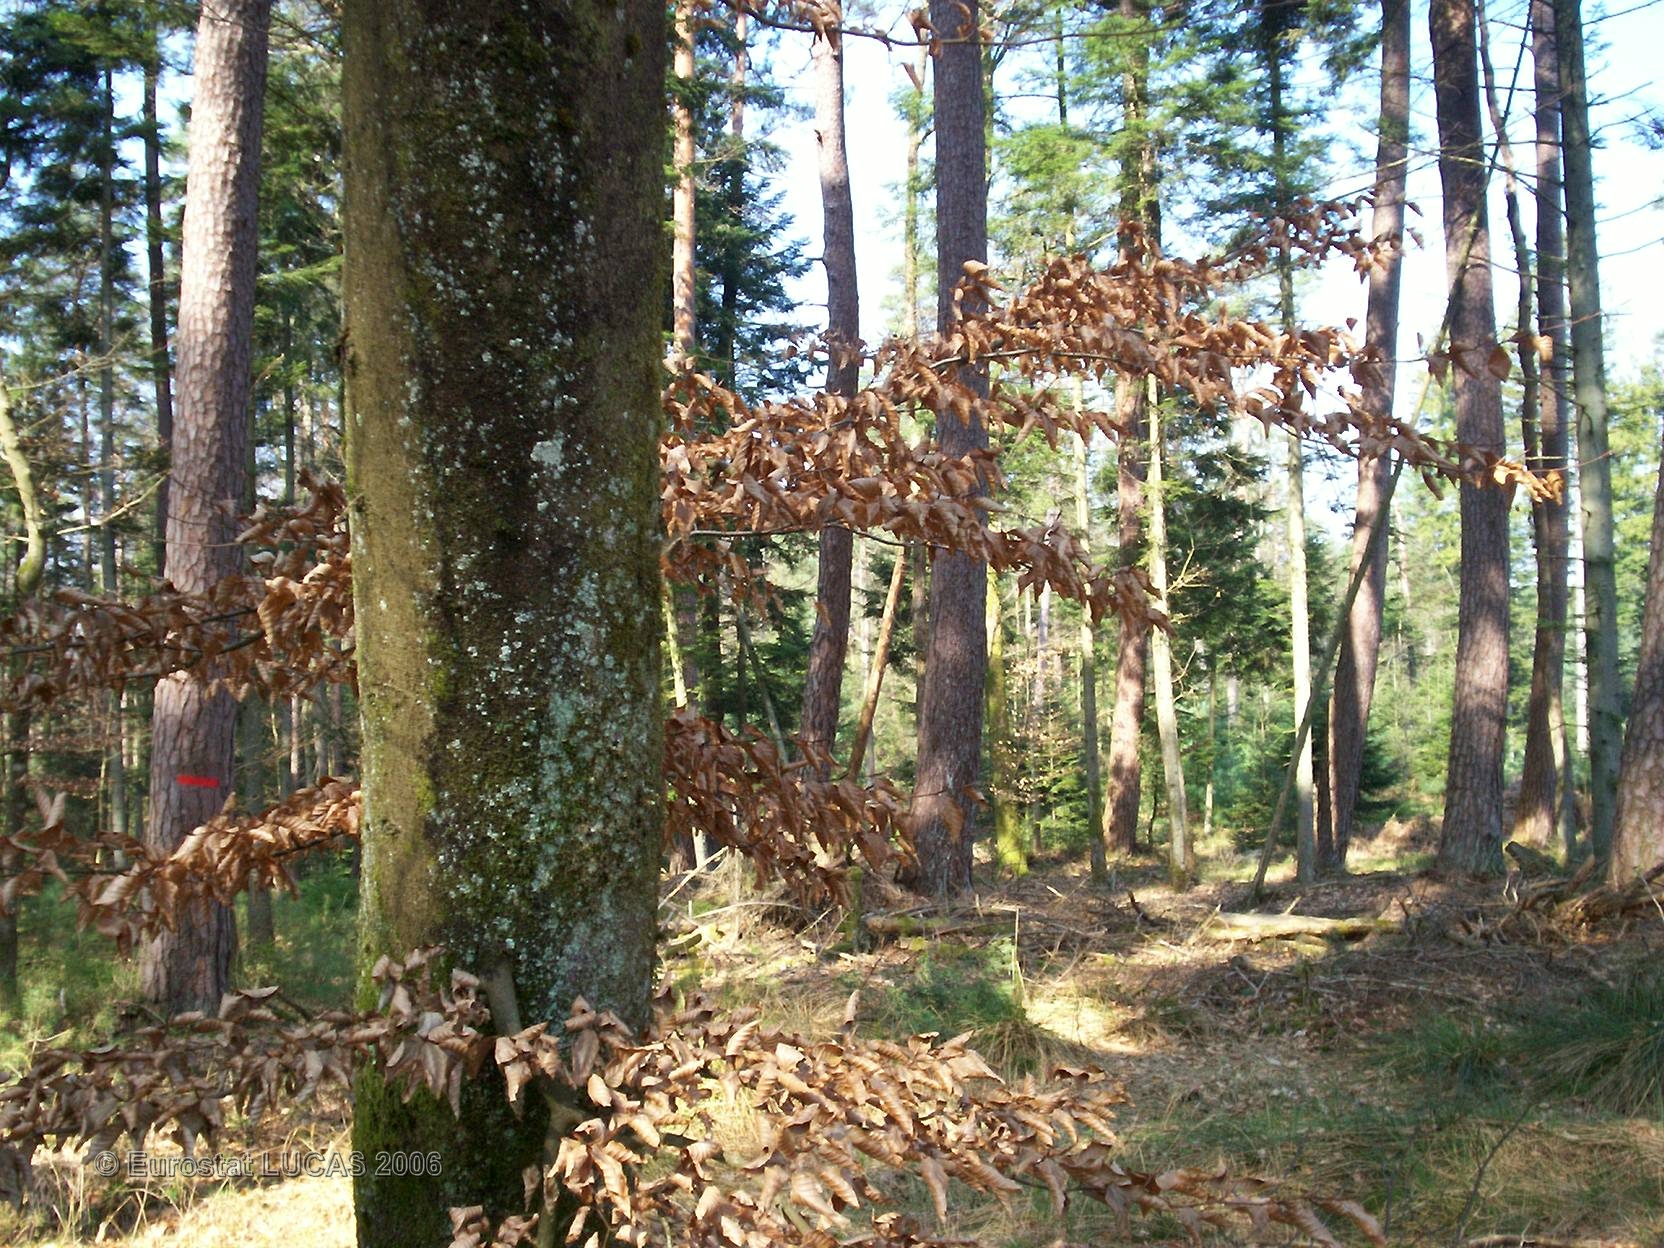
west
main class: Woodland
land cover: Coniferous forest
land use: Forestry
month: April
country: FR
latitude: 48.2071
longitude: 6.5963
